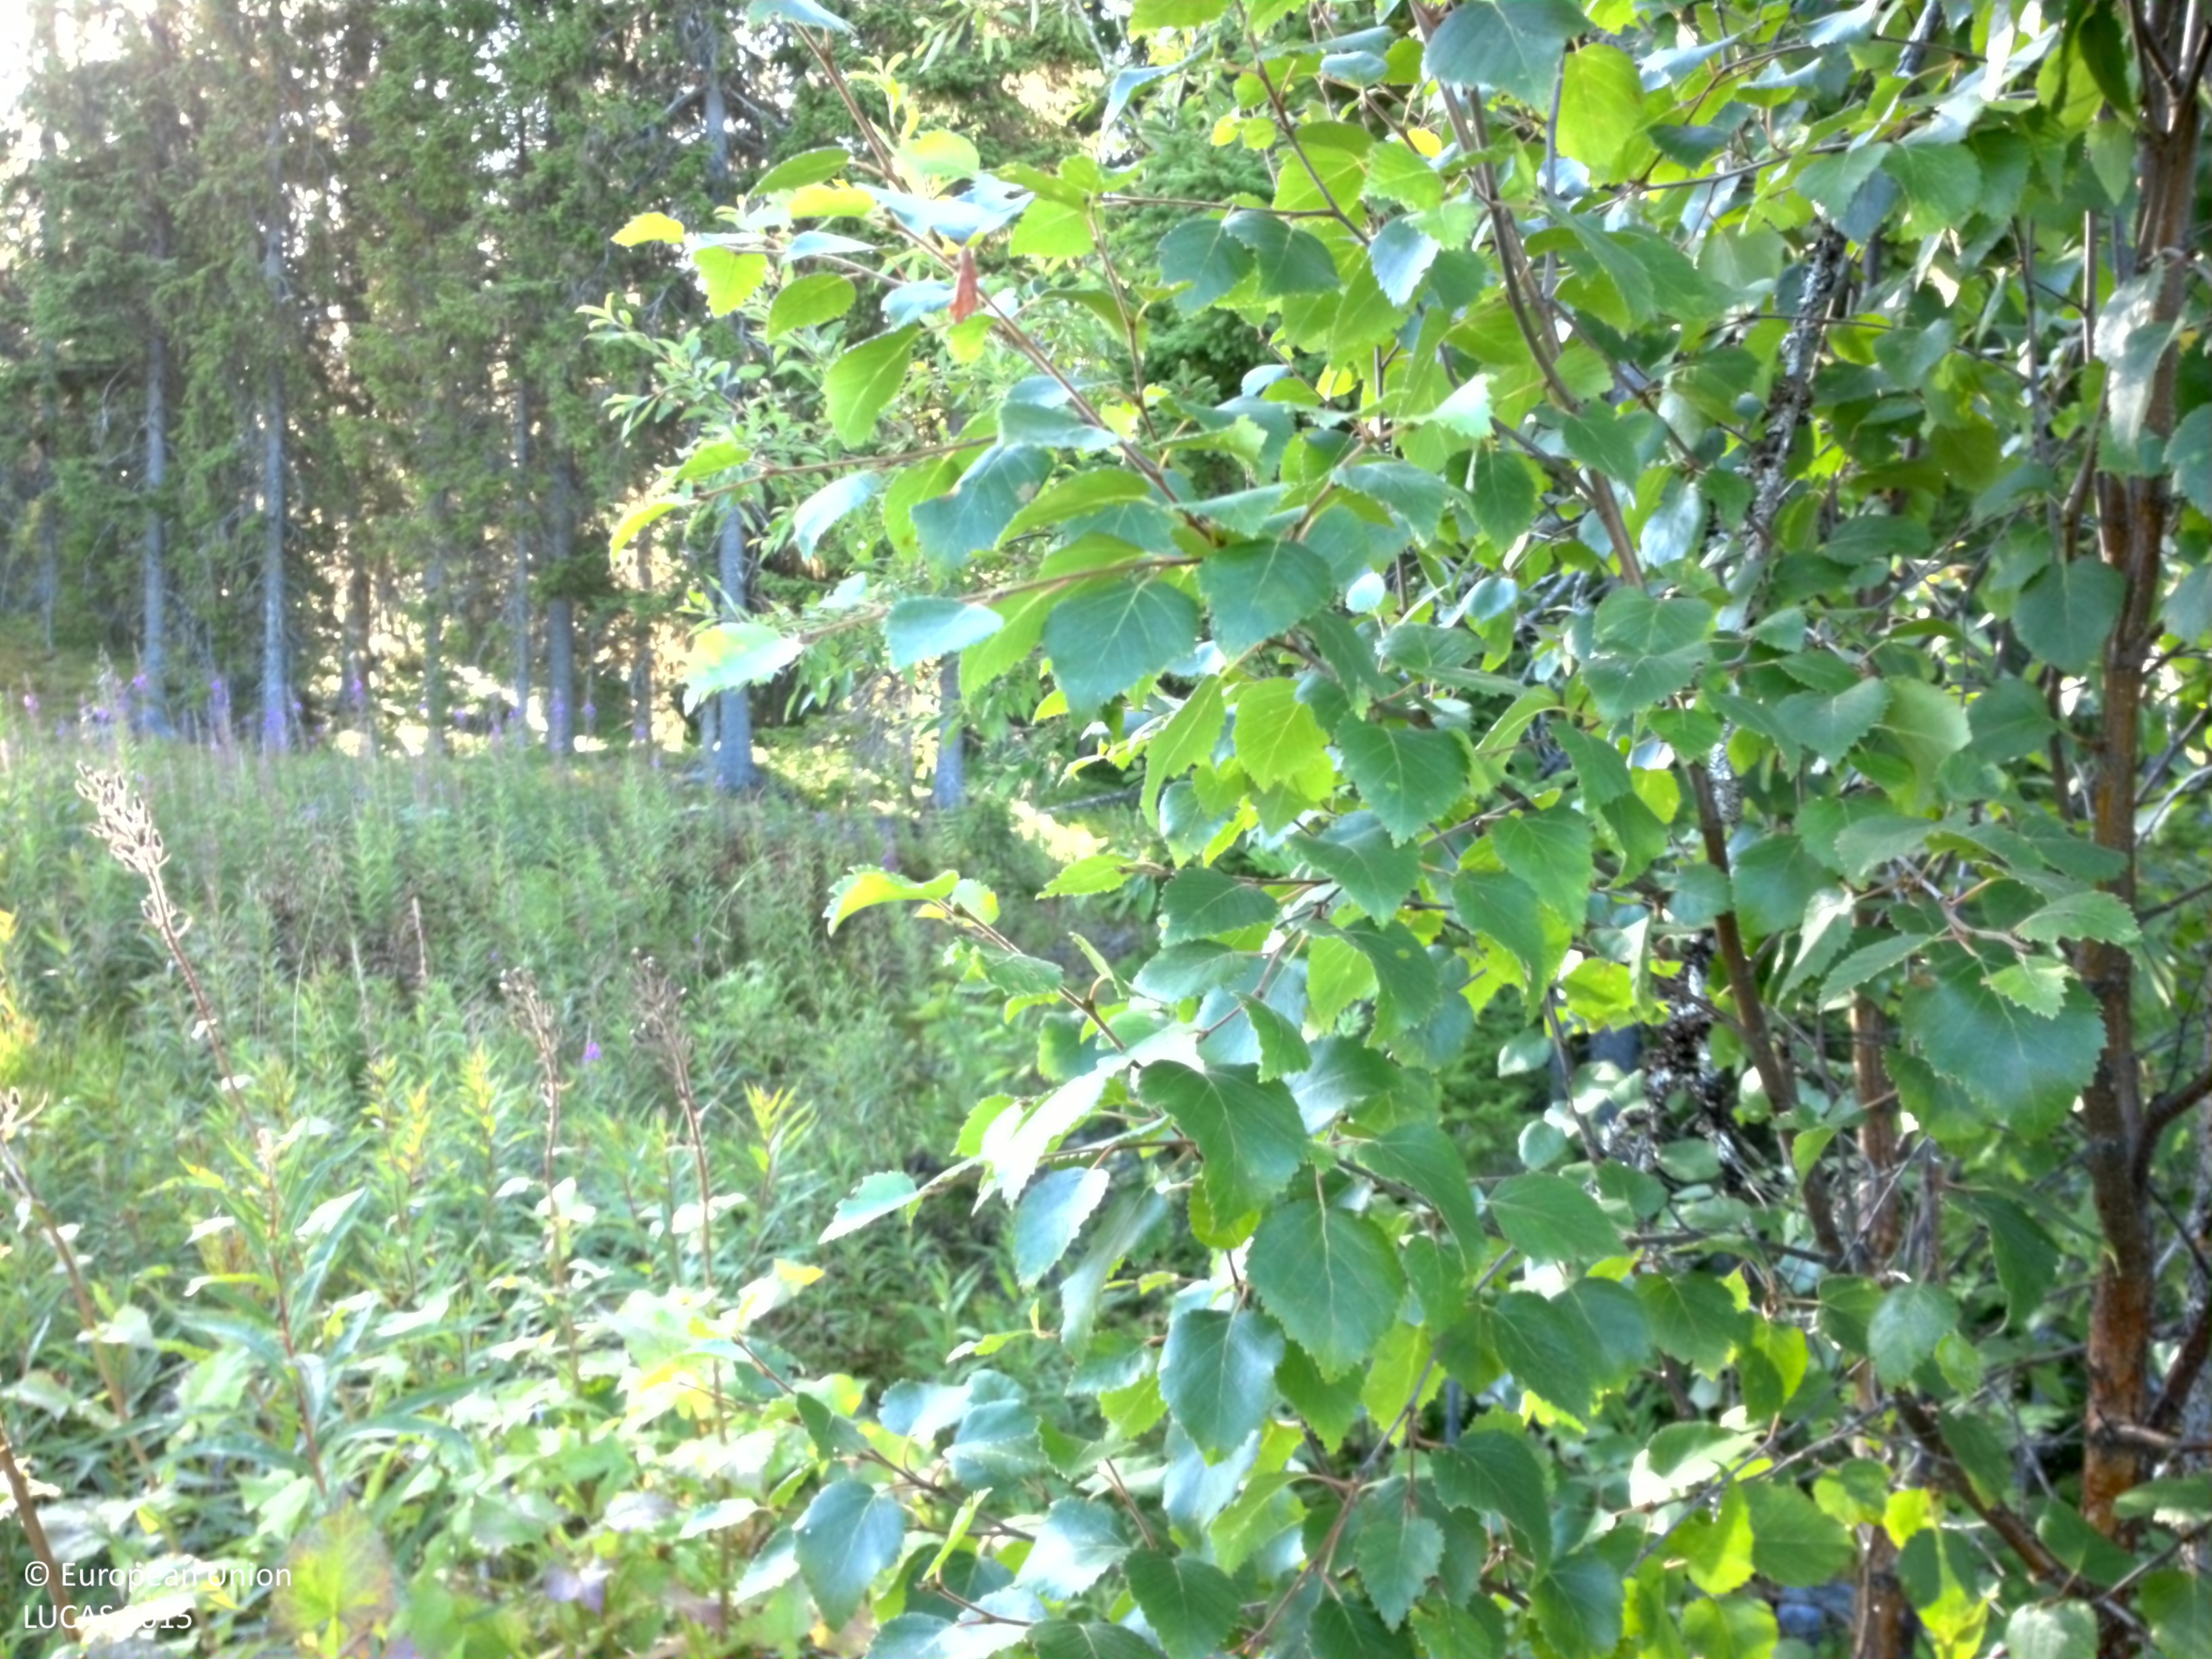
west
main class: Woodland
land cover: Spruce dominated mixed woodland
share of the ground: 10 - 25 %
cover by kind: herbaceous plants 75 %, broadleaved forest trees 10 %, shrubs 10 %, coniferous forest trees 5 %
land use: Forestry
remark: Clear cut
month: August
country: SE
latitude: 64.6972
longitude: 16.1115
